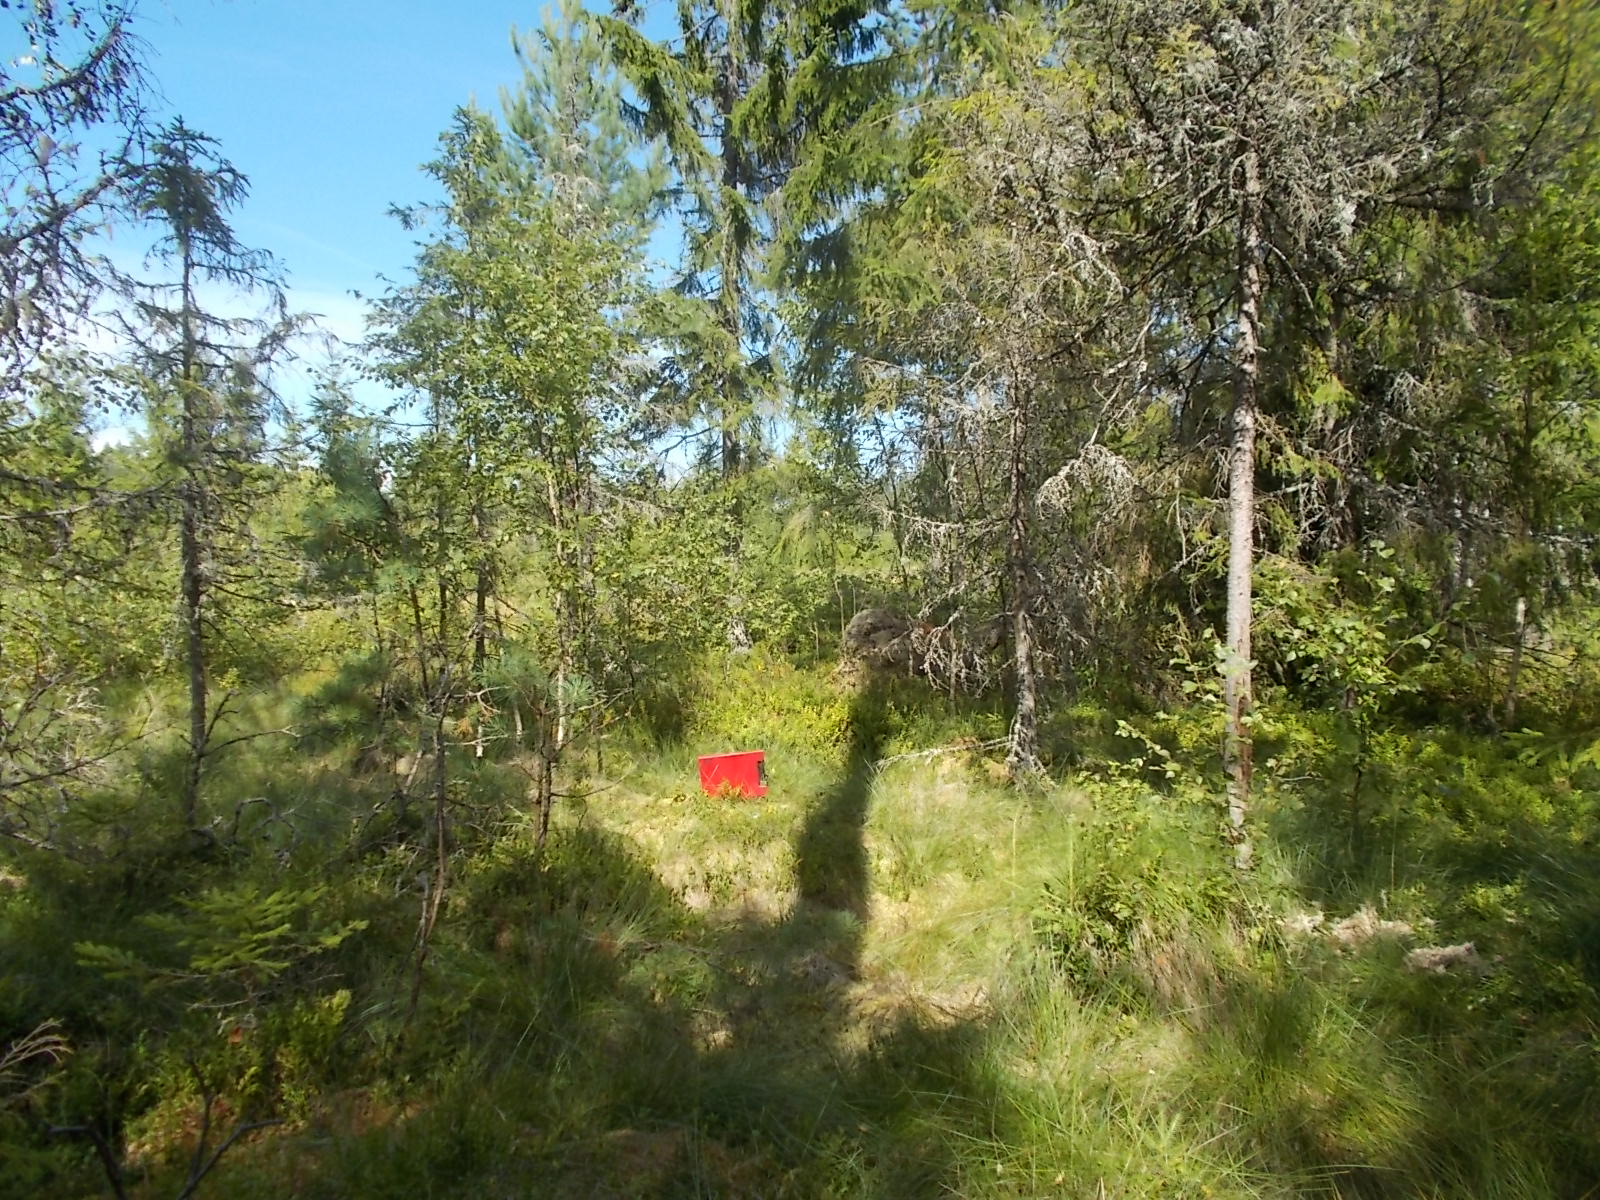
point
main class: Woodland
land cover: Other mixed woodland
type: hemiboreal forest and nemoral coniferous forest and mixed broadleaved-coniferous forest
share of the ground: 50 - 75 %
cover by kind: coniferous forest trees 35 %, broadleaved forest trees 25 %, herbaceous plants 15 %, lichens and mosses 15 %, shrubs 10 %
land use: Forestry
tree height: > 5 m
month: August
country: LV
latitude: 57.1834
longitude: 22.2432
